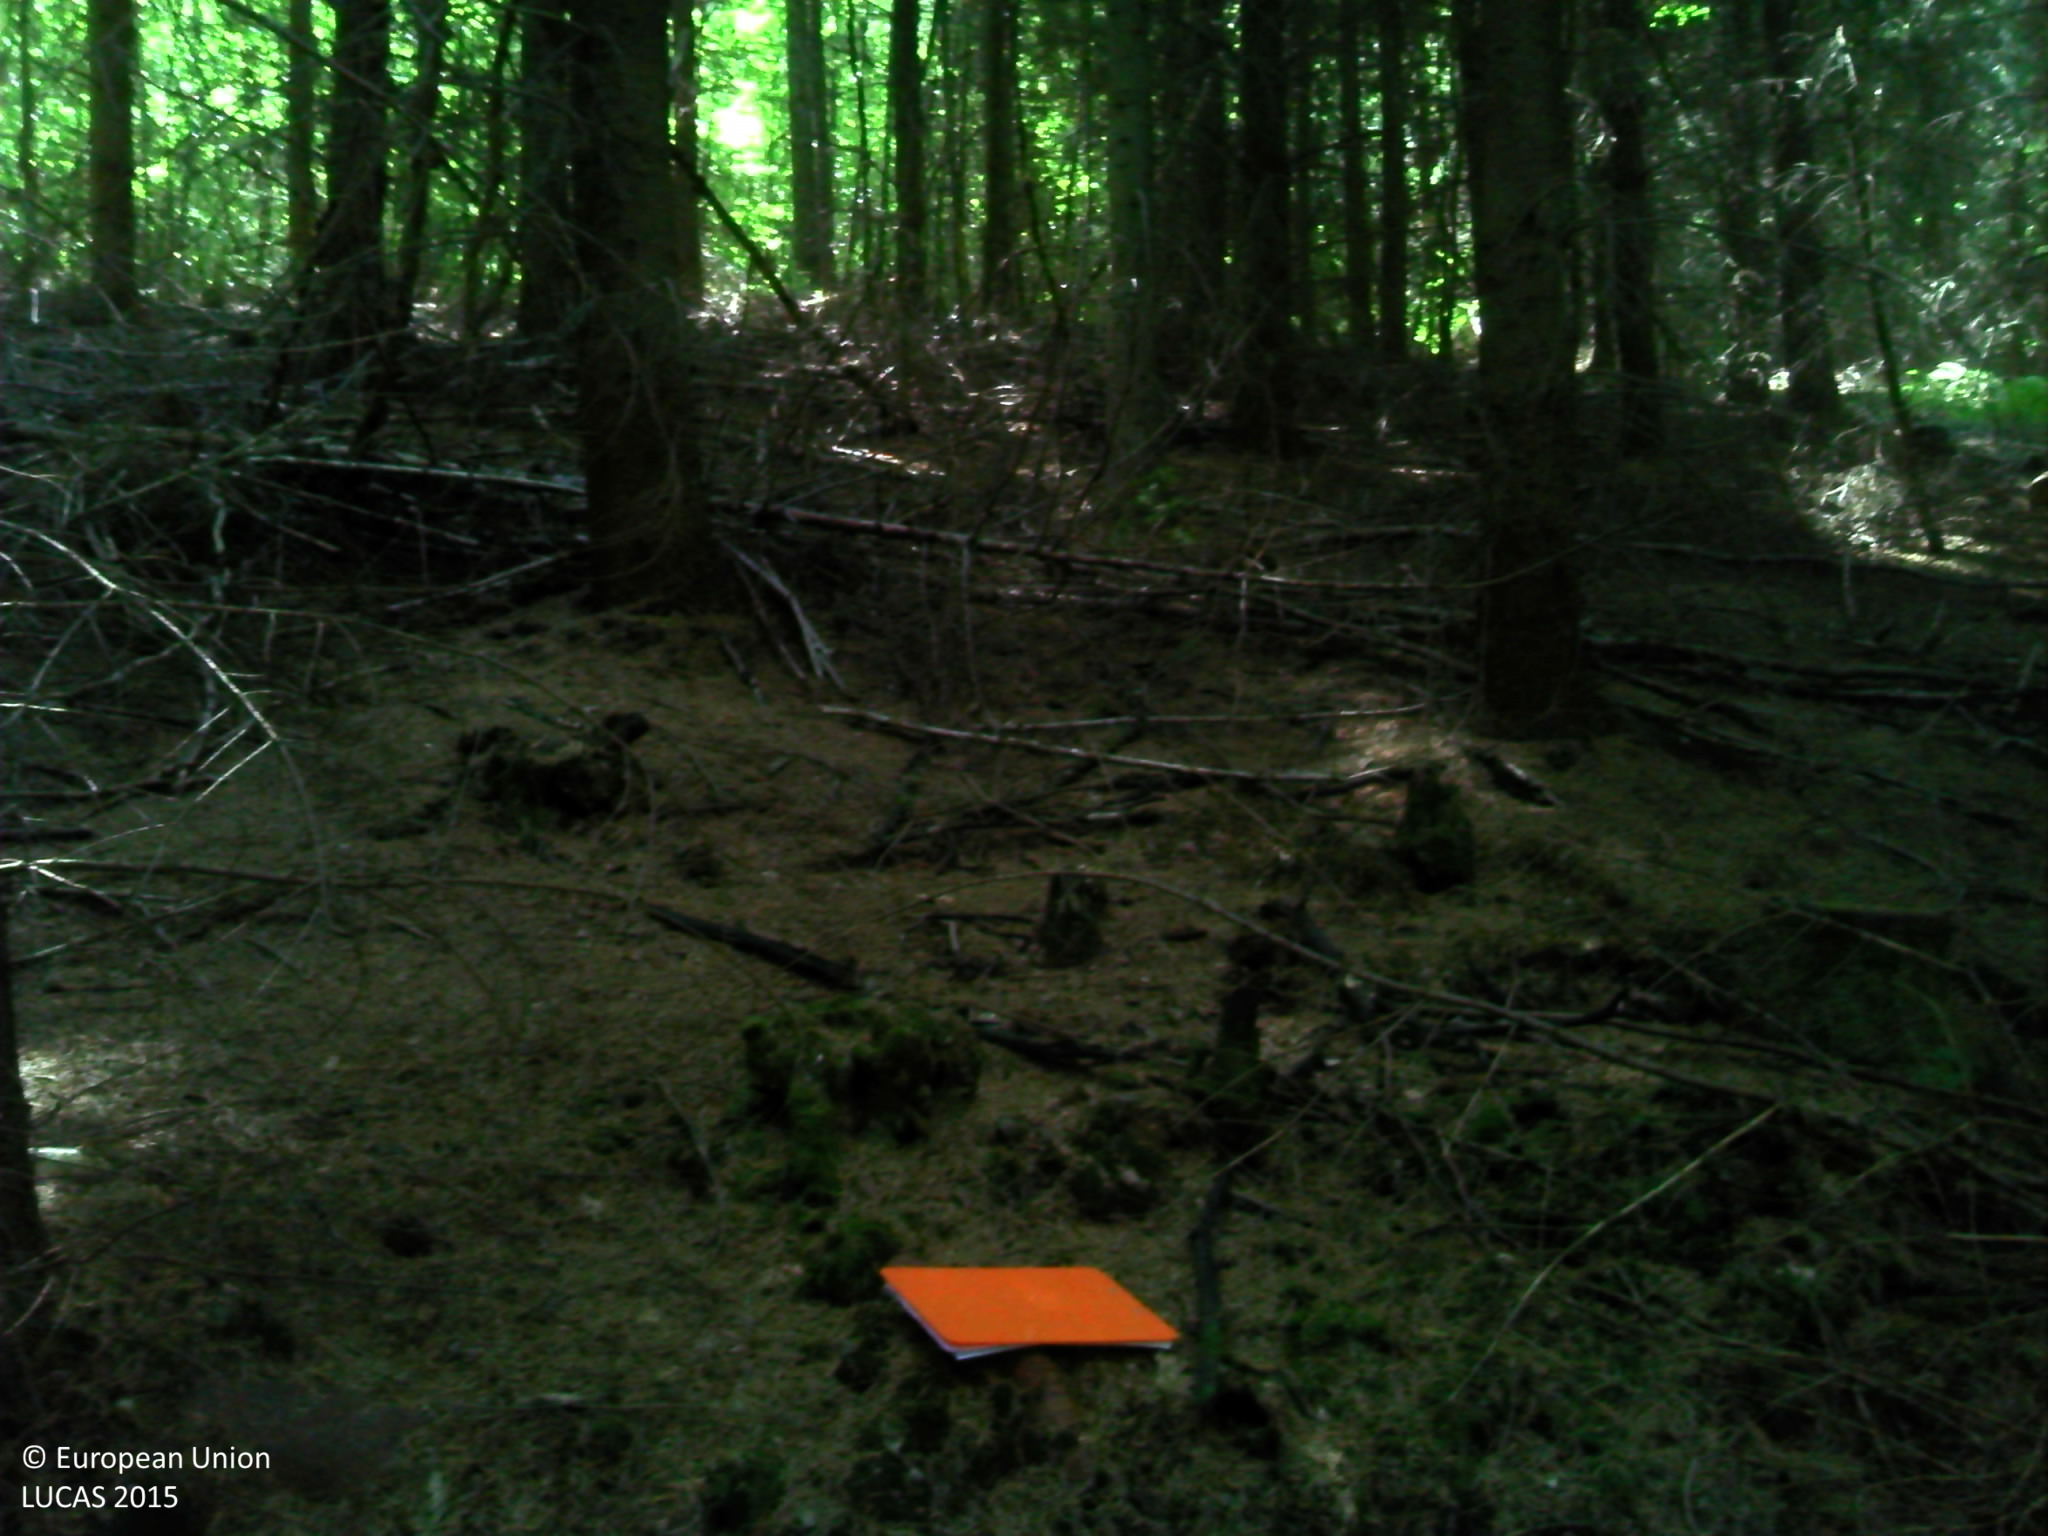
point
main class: Woodland
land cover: Spruce dominated coniferous woodland
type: hemiboreal forest and nemoral coniferous forest and mixed broadleaved-coniferous forest
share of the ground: > 75 %
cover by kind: coniferous forest trees 80 %, herbaceous plants 20 %
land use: Forestry
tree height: > 5 m
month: August
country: FR
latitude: 45.7078
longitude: 4.5699
